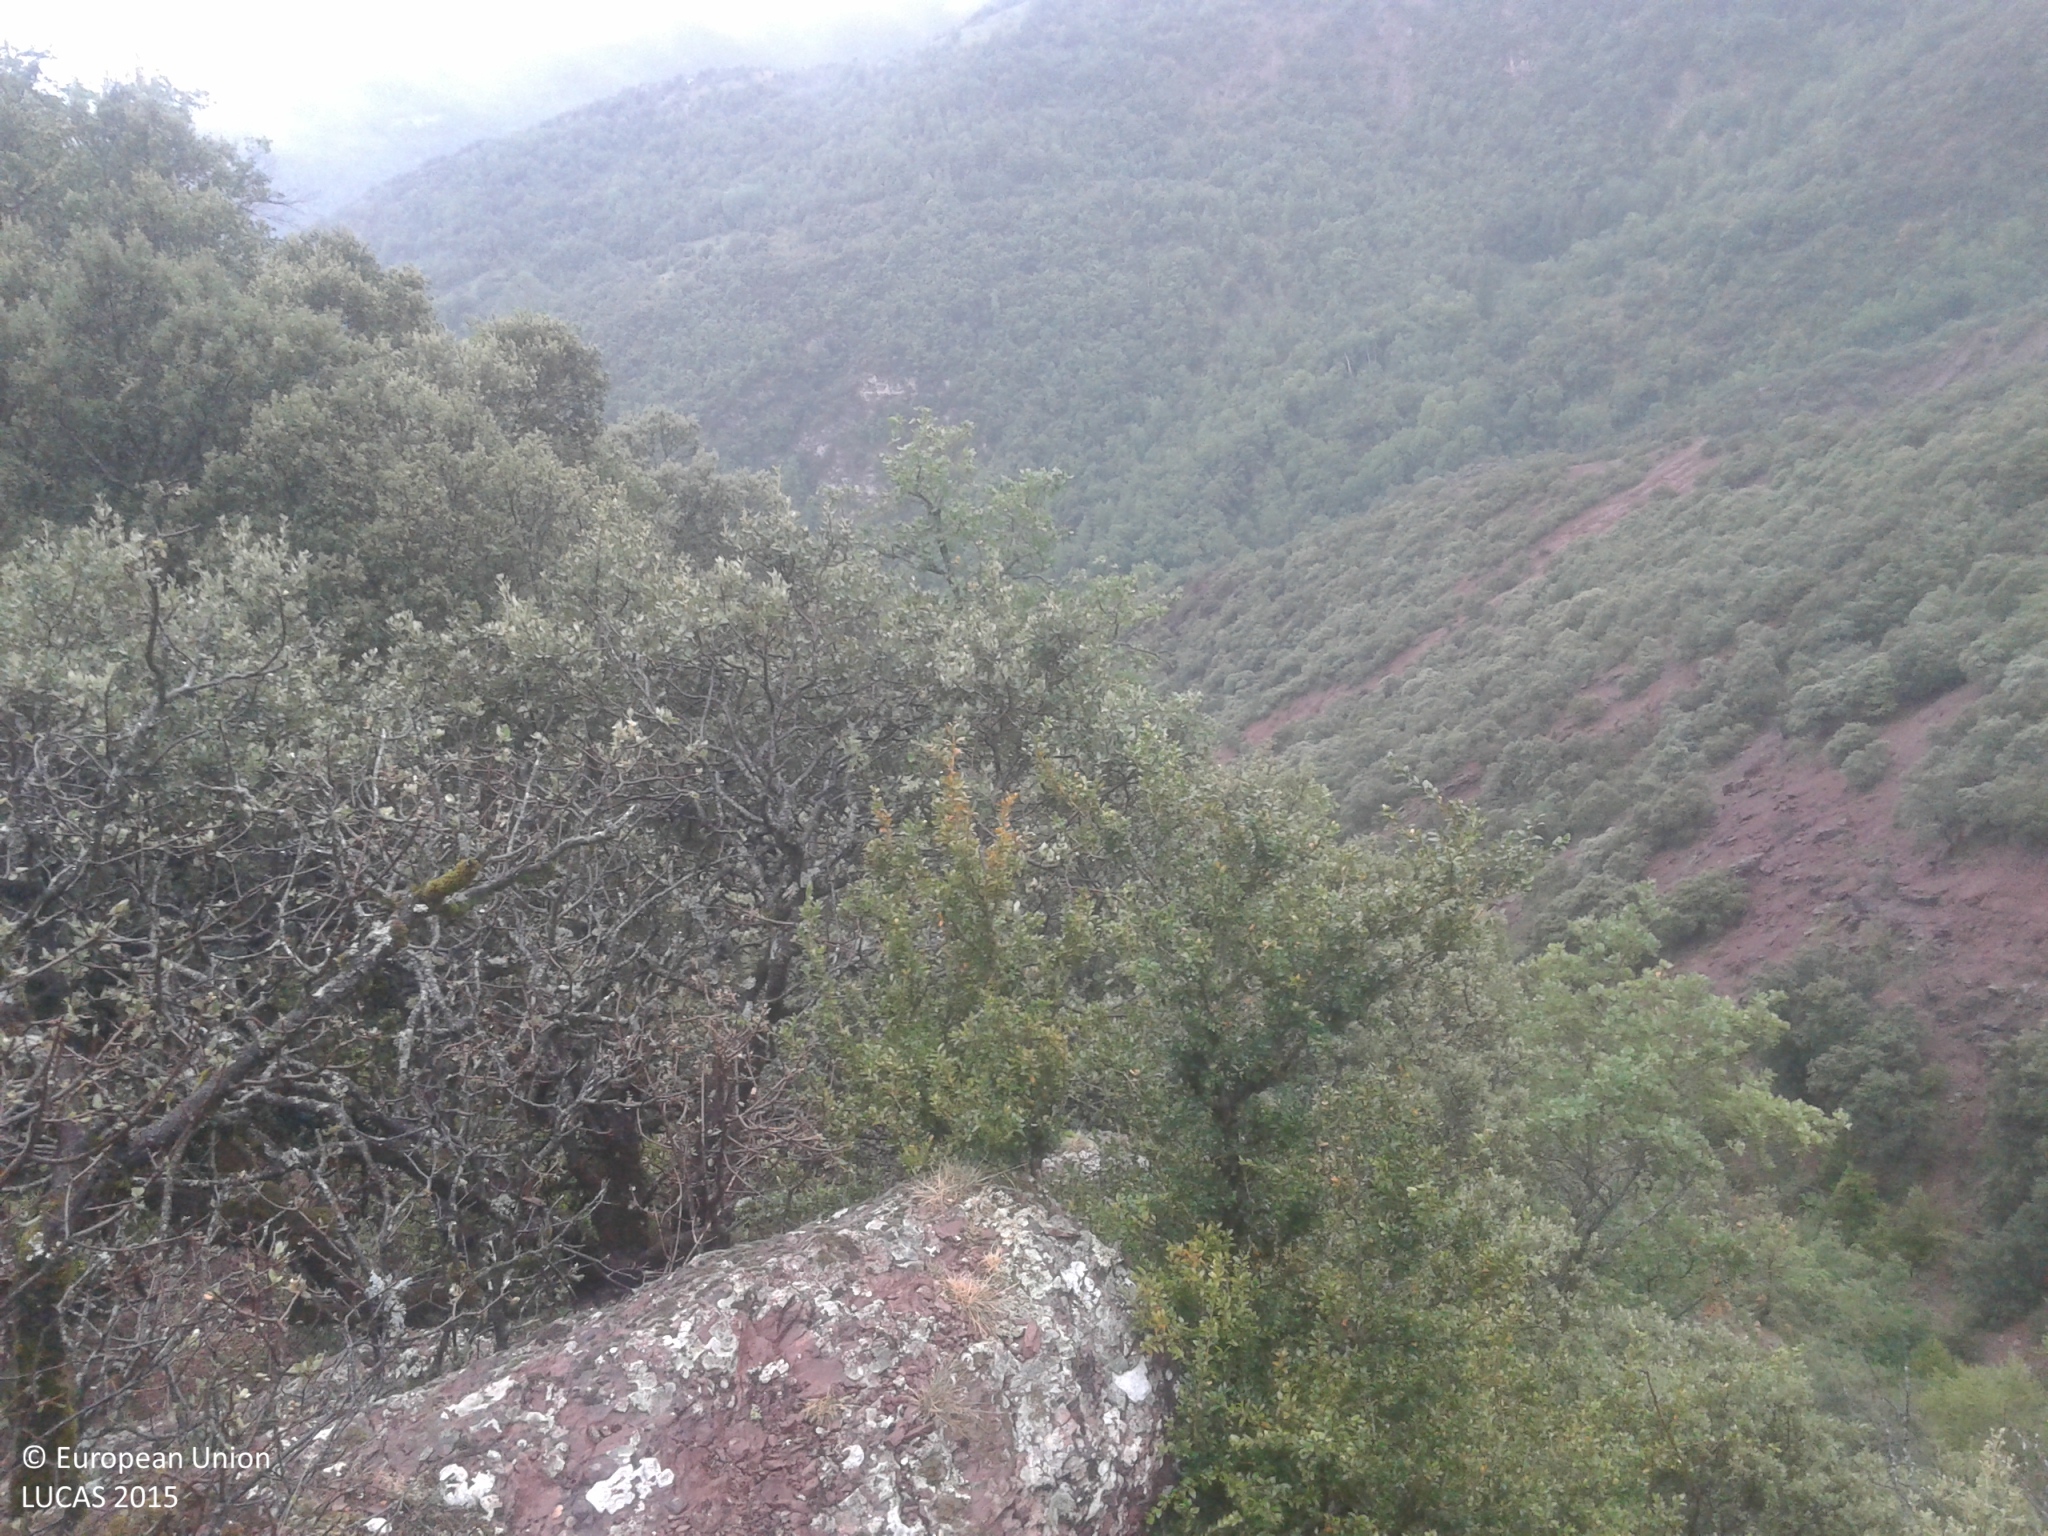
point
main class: Woodland
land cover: Broadleaved woodland
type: broadleaved evergreen forest
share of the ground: > 75 %
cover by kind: broadleaved forest trees 90 %, shrubs 10 %
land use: Semi-natural and natural areas not in use
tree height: > 5 m
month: August
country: ES
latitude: 42.3848
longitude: 1.0564
